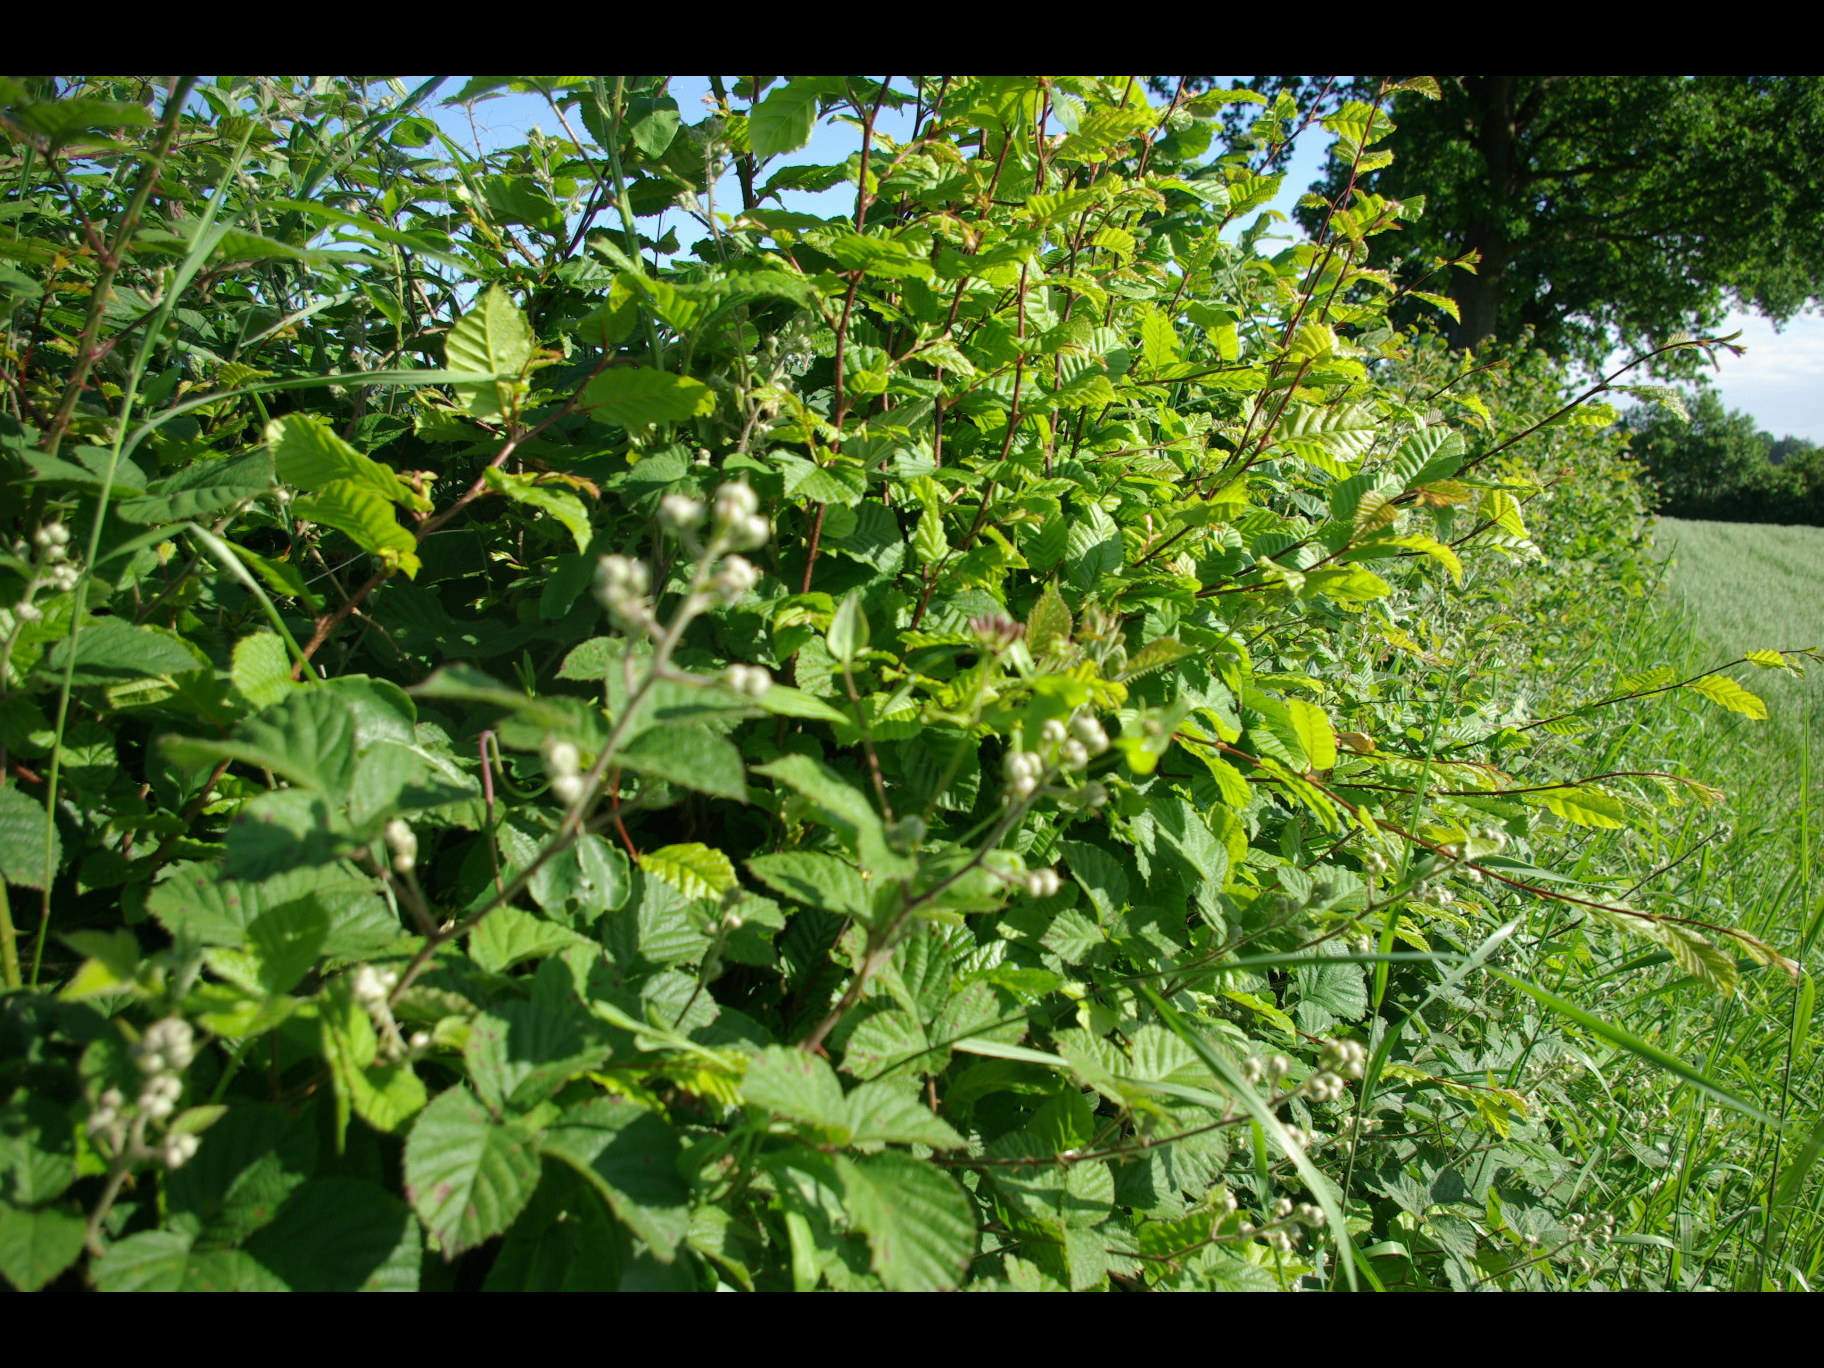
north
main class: Woodland
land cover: Broadleaved woodland
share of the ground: > 75 %
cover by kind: broadleaved forest trees 40 %, shrubs 40 %, herbaceous plants 20 %
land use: Agriculture (excluding fallow land and kitchen gardens)
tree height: > 5 m
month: June
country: DE
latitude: 54.3724
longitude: 9.9538
